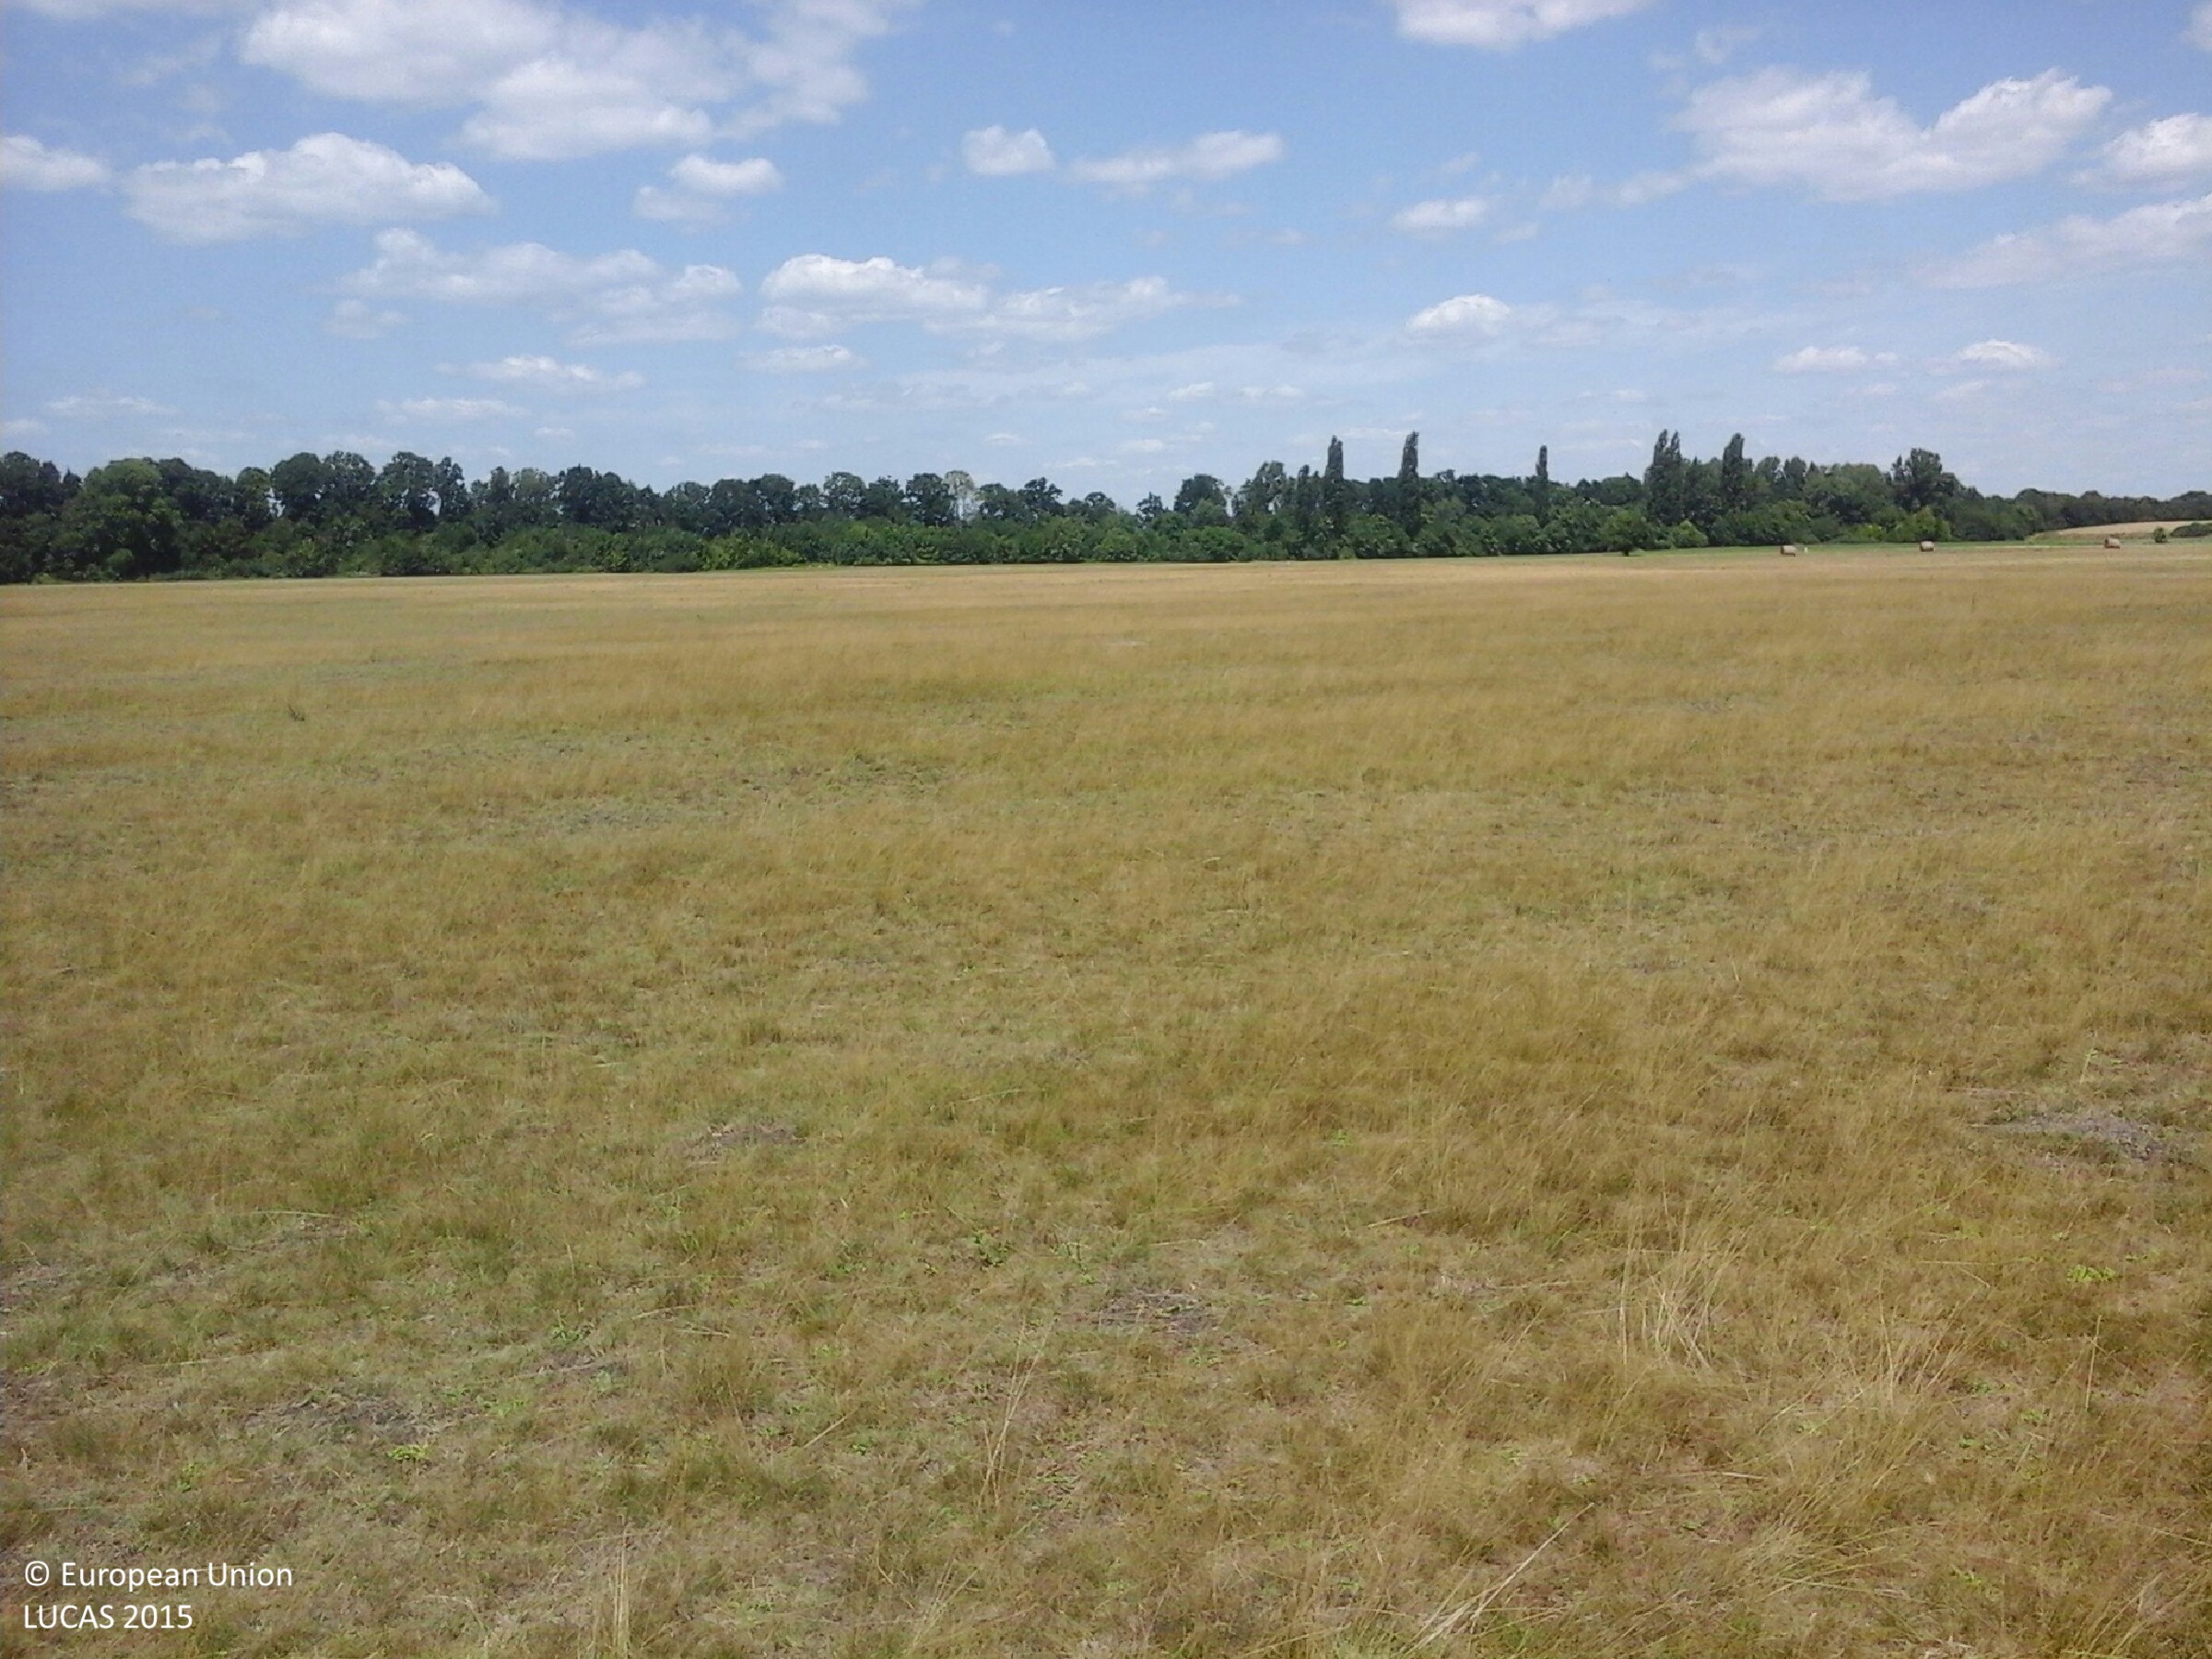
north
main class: Grassland
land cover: Grassland without tree/shrub cover
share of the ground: > 75 %
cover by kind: herbaceous plants 95 %, unconsolidated bare surface 5 %
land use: Agriculture (excluding fallow land and kitchen gardens)
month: July
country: HU
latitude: 47.8479
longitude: 20.6852
